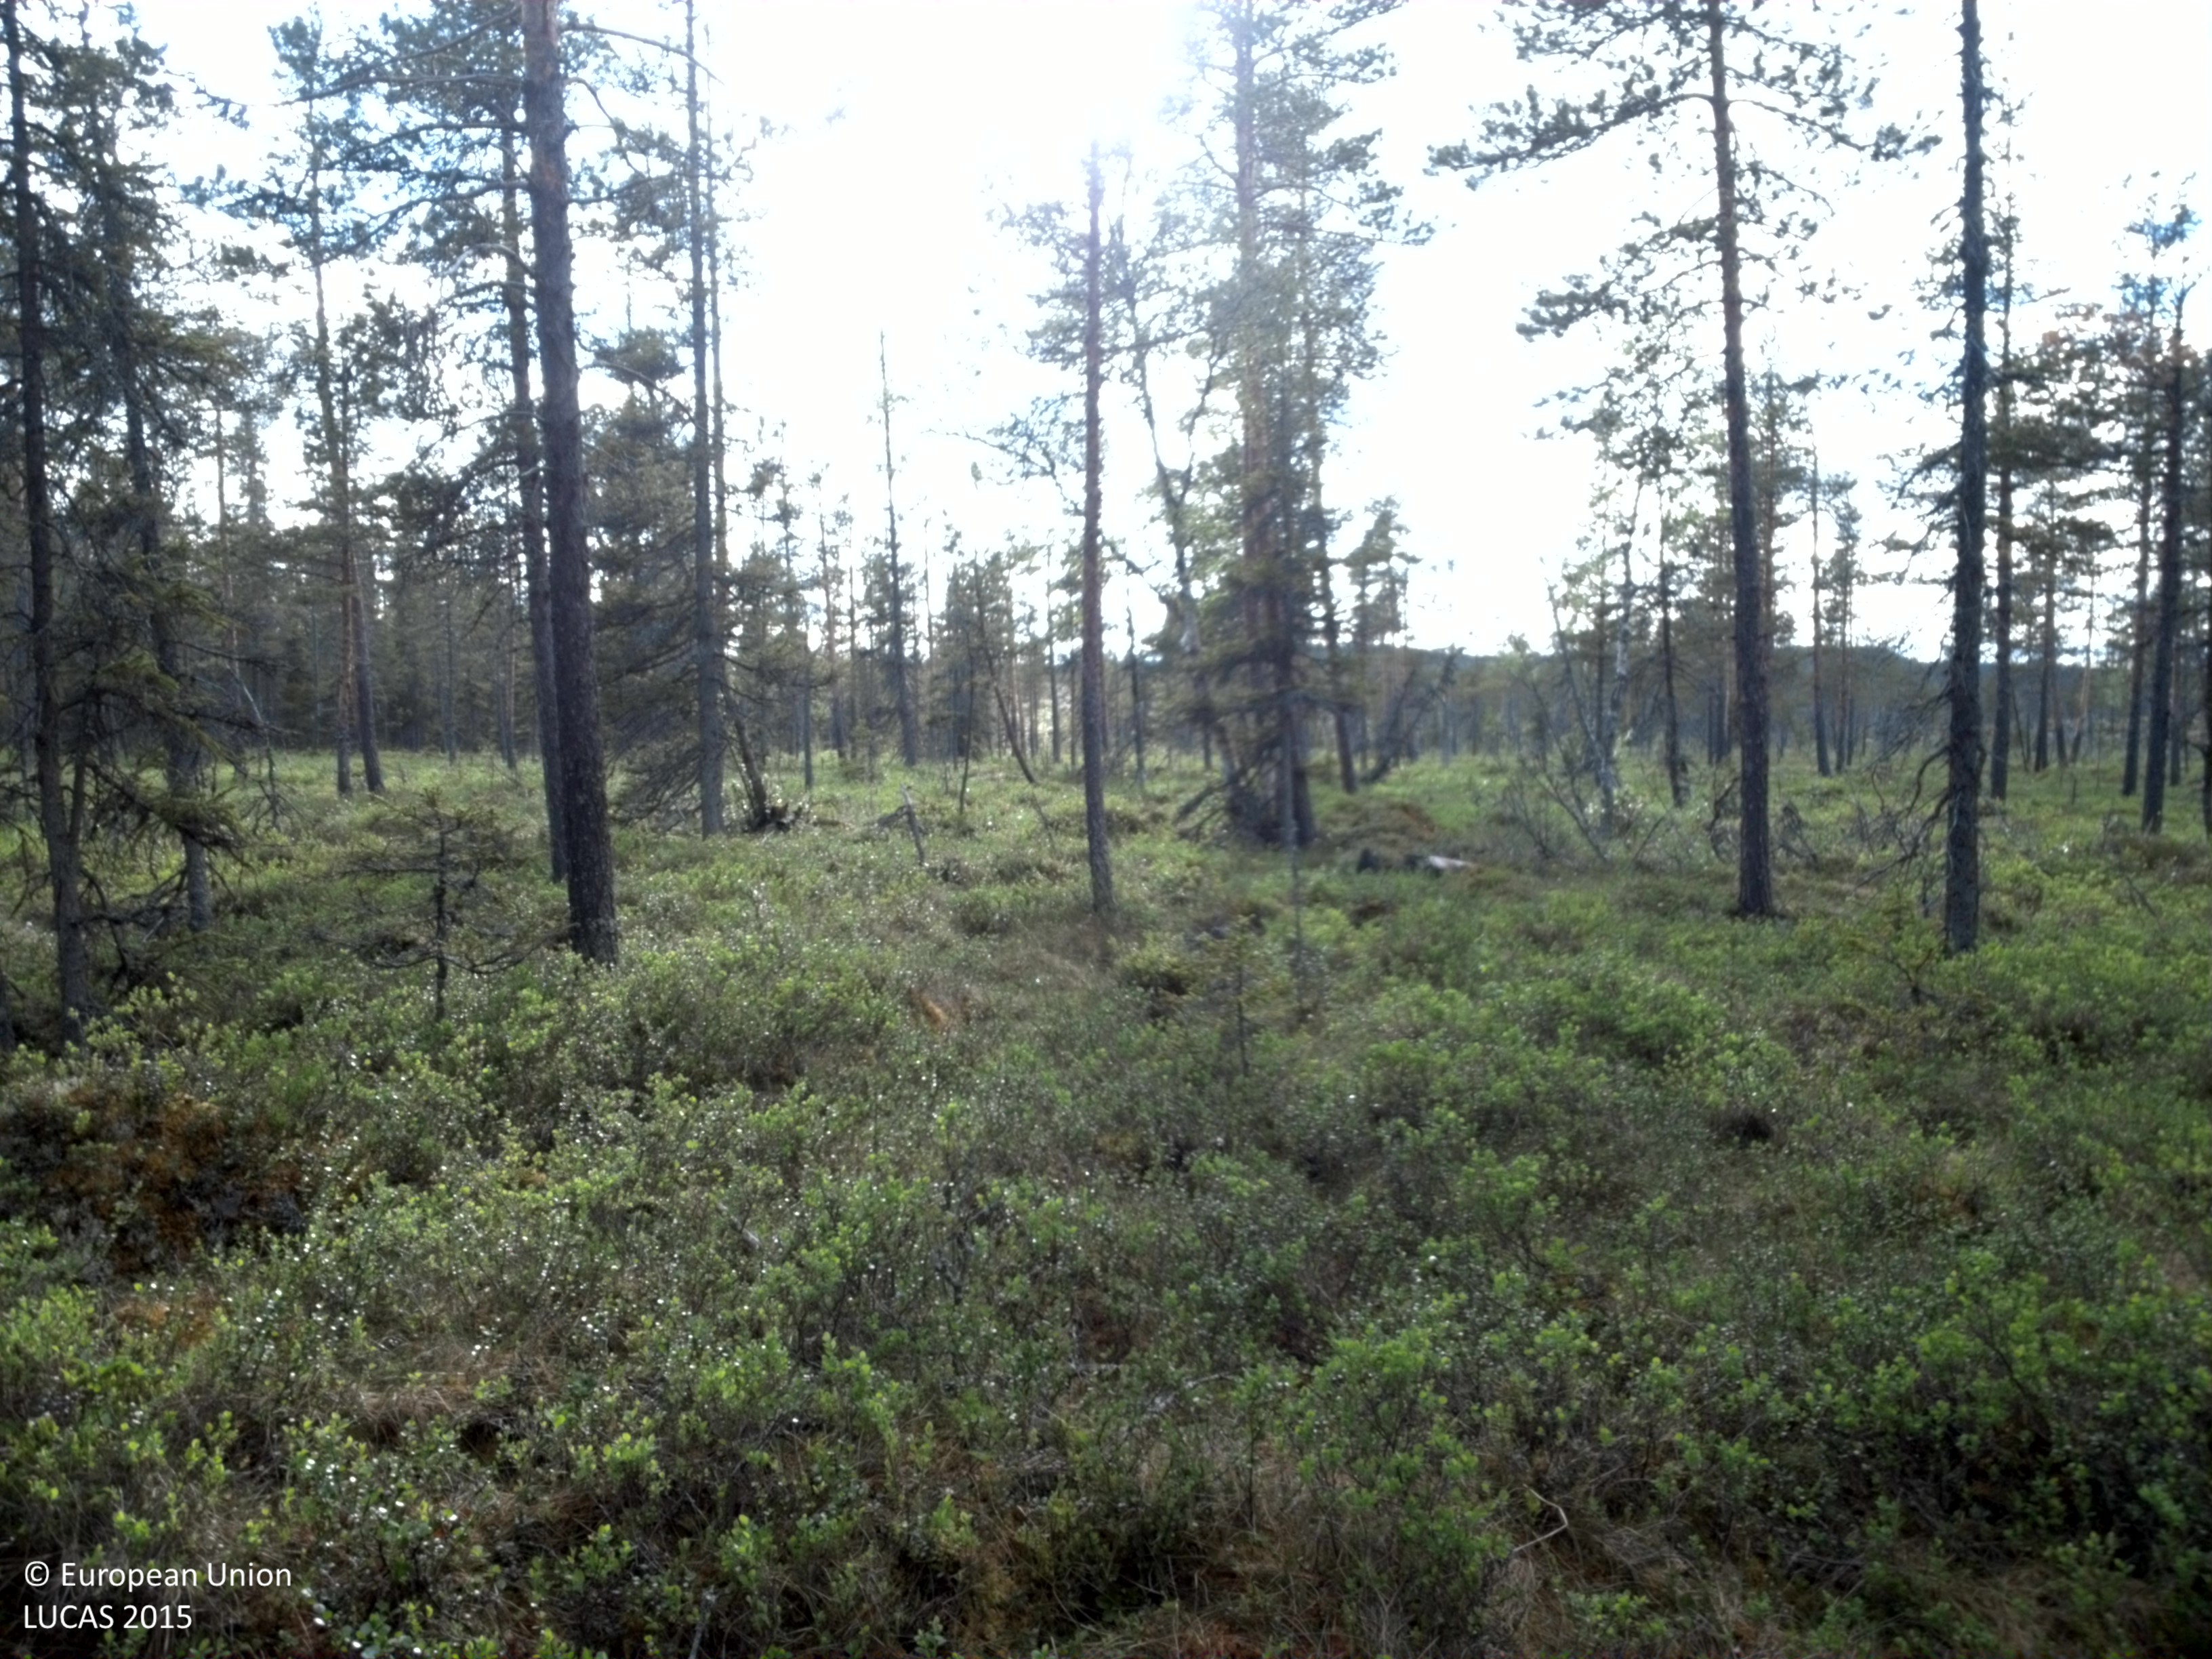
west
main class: Woodland
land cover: Other coniferous woodland
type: boreal forest
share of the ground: 25 - 50 %
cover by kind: shrubs 40 %, coniferous forest trees 25 %, lichens and mosses 20 %, herbaceous plants 15 %
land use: Forestry
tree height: > 5 m
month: June
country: SE
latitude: 61.8512
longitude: 12.5546
